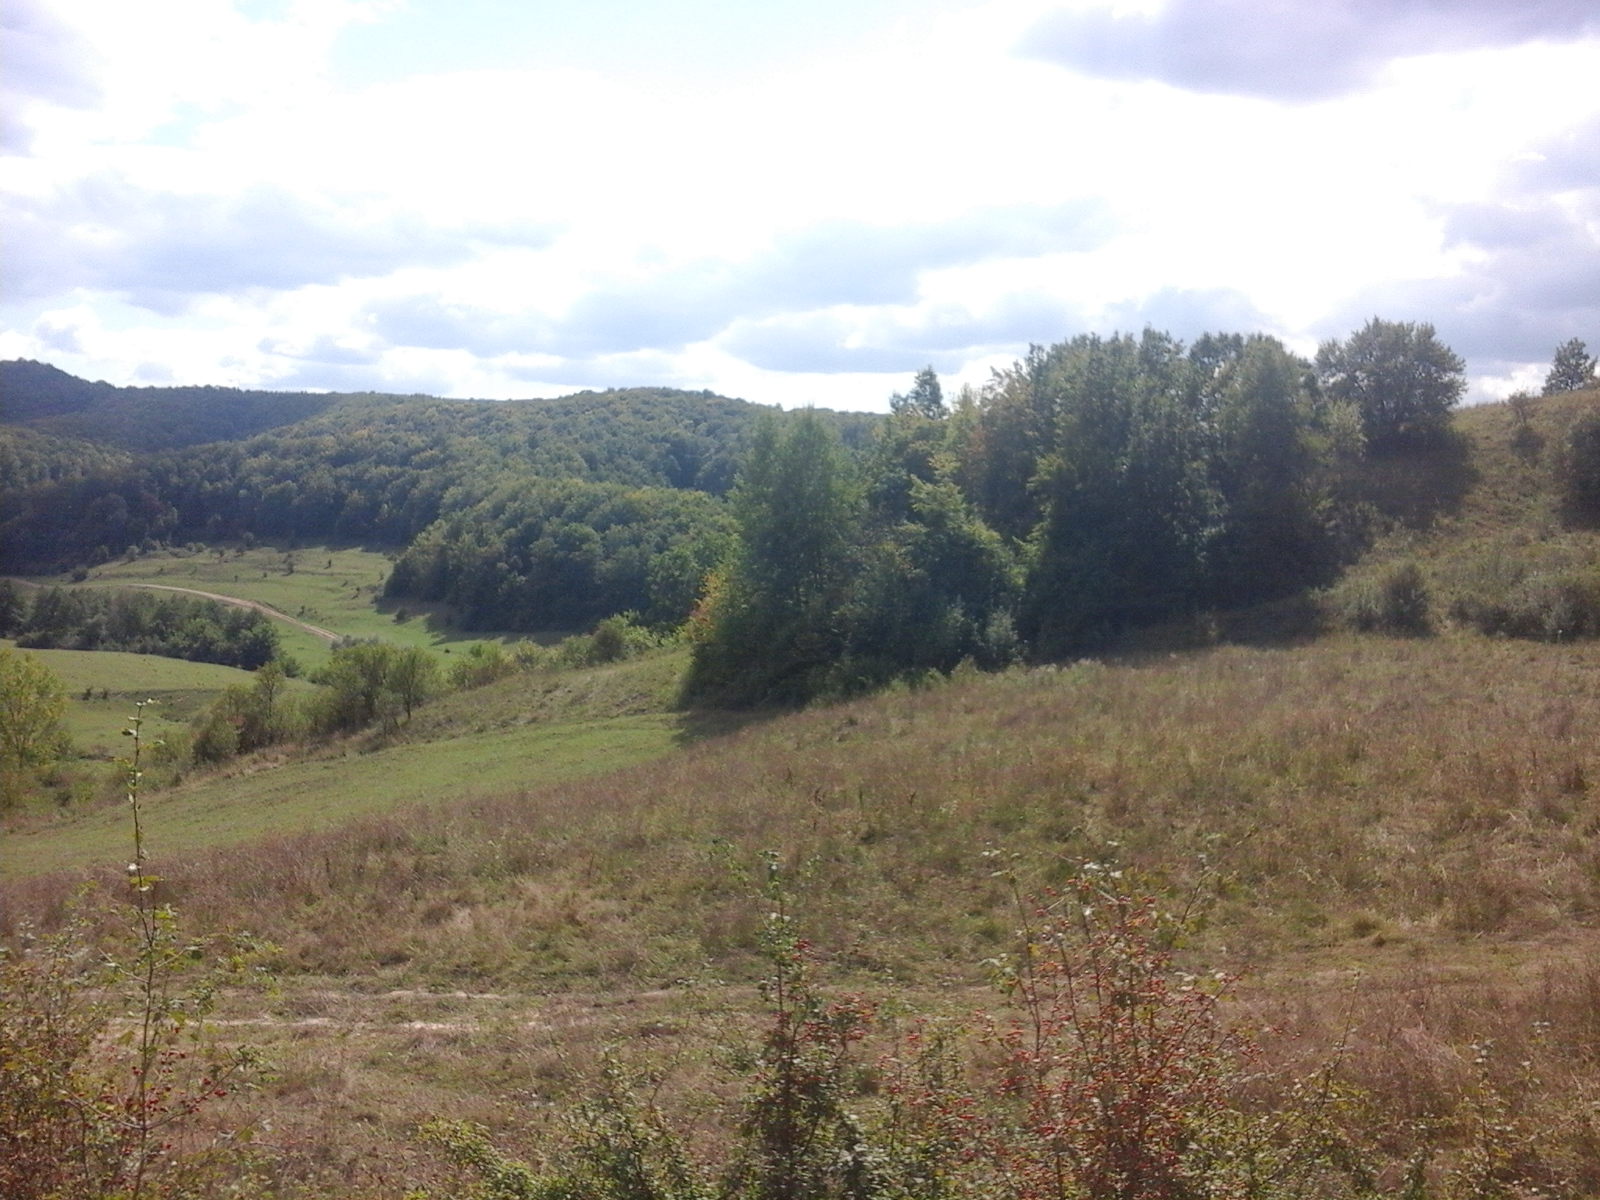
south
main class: Grassland
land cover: Grassland with sparse tree/shrub cover
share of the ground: > 75 %
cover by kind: herbaceous plants 85 %, shrubs 10 %, broadleaved forest trees 5 %
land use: Fallow land
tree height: < 5 m
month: September
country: RO
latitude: 47.3663
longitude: 23.6755
